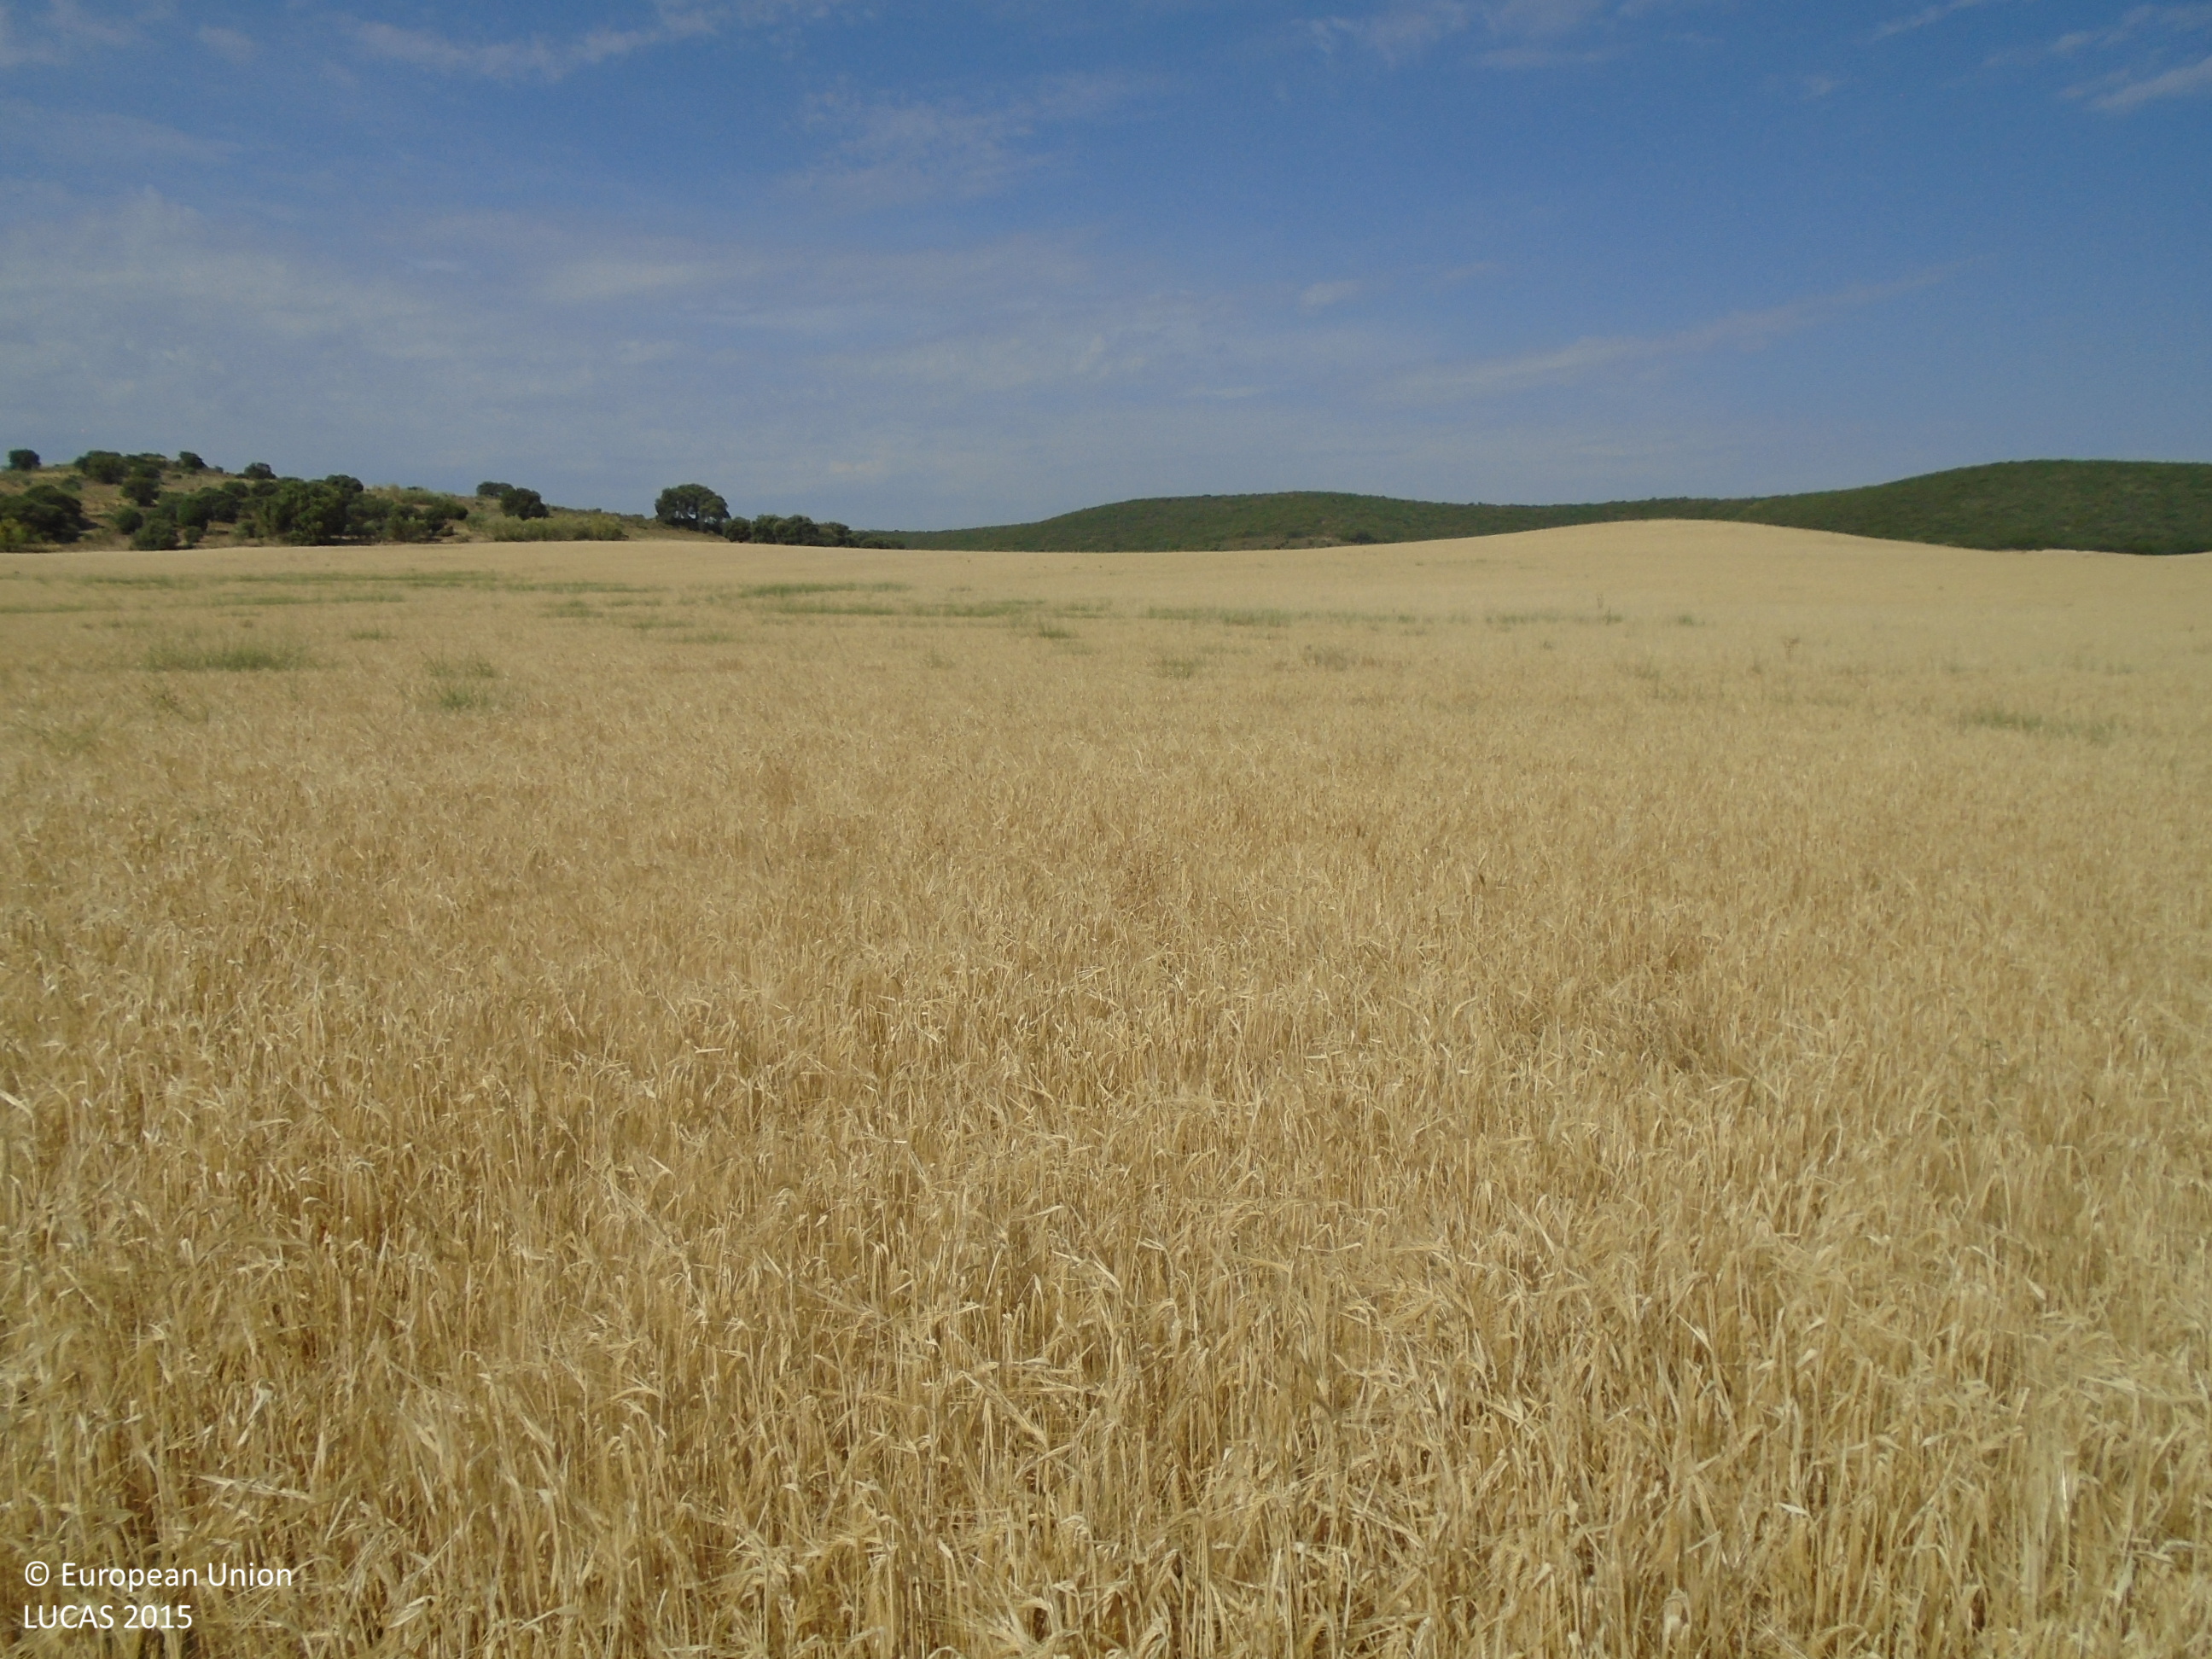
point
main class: Cropland
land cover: Barley
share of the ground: > 75 %
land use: Agriculture (excluding fallow land and kitchen gardens)
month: June
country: ES
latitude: 39.8112
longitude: -4.2292
